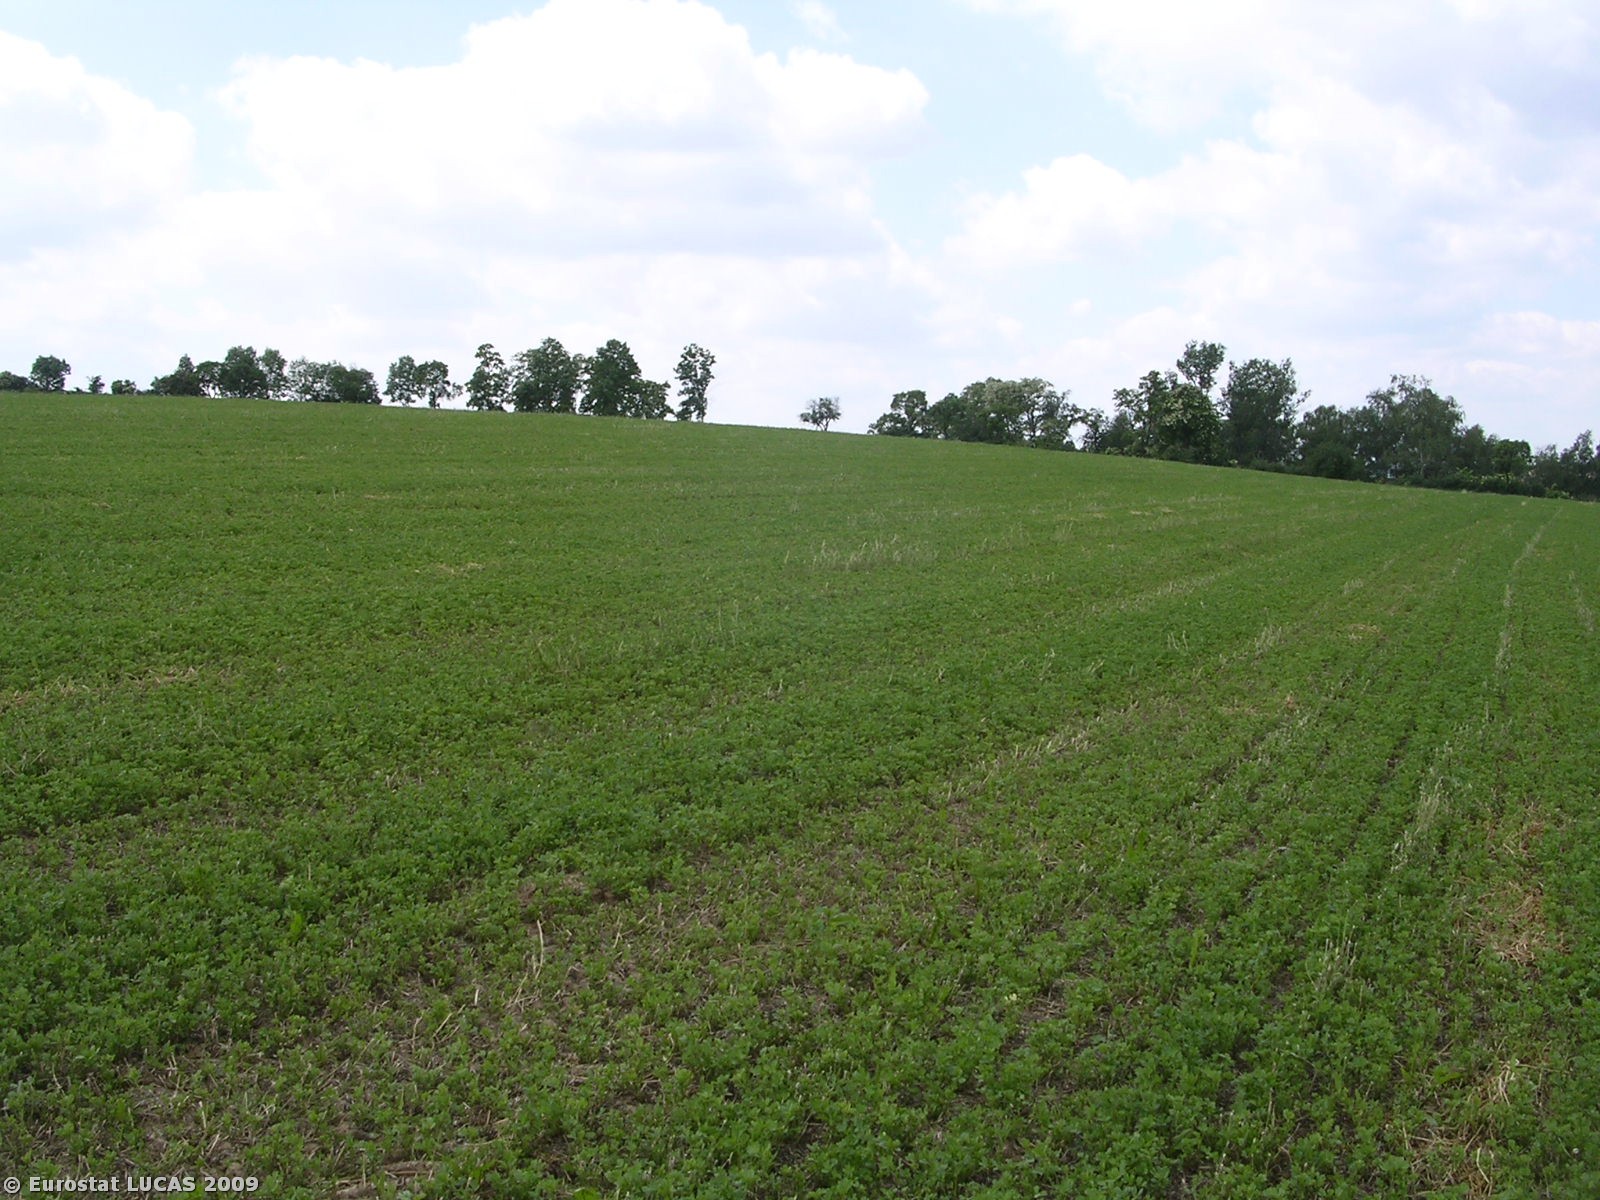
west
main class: Cropland
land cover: Lucerne
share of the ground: > 75 %
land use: Agriculture (excluding fallow land and kitchen gardens)
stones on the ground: < 10 %
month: May
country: CZ
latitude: 50.3212
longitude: 14.7073
